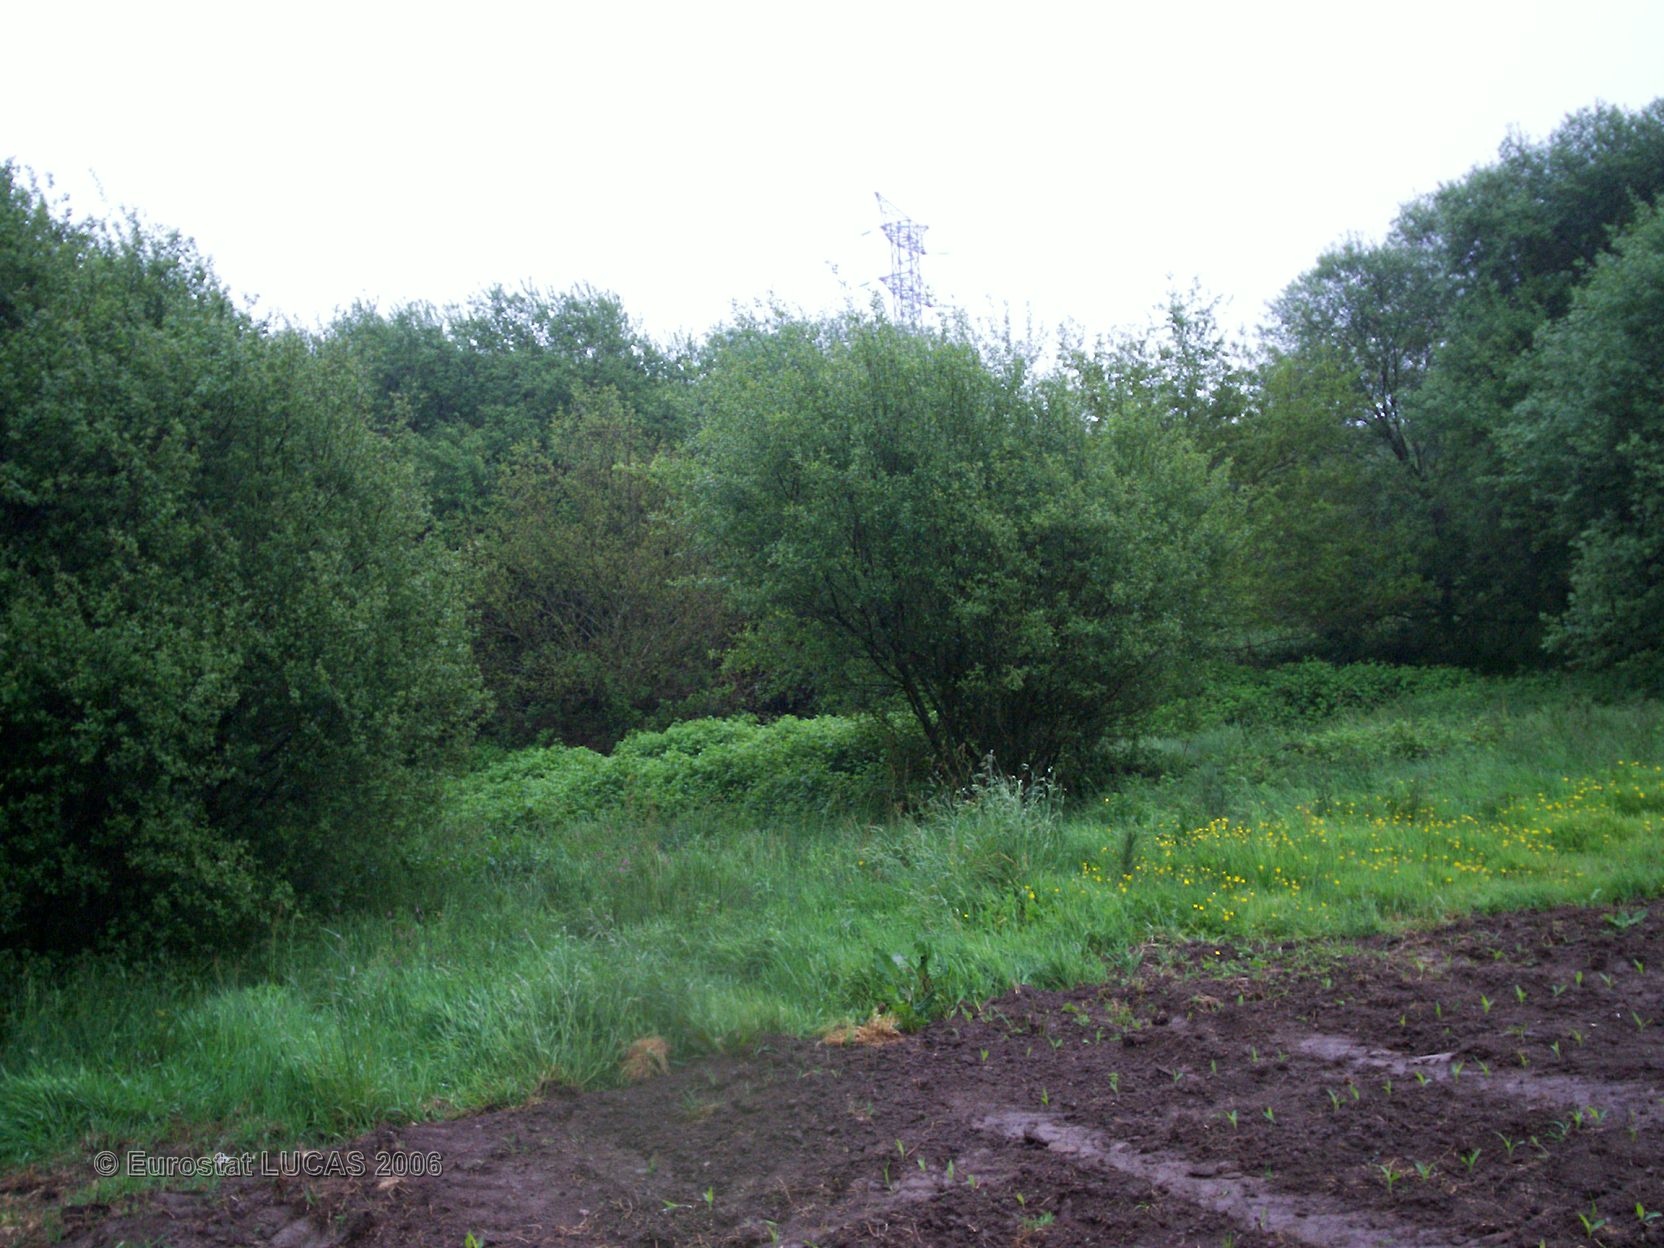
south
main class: Cropland
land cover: Maize
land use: Agriculture (excluding fallow land and kitchen gardens)
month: May
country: FR
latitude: 47.9099
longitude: -3.8501
